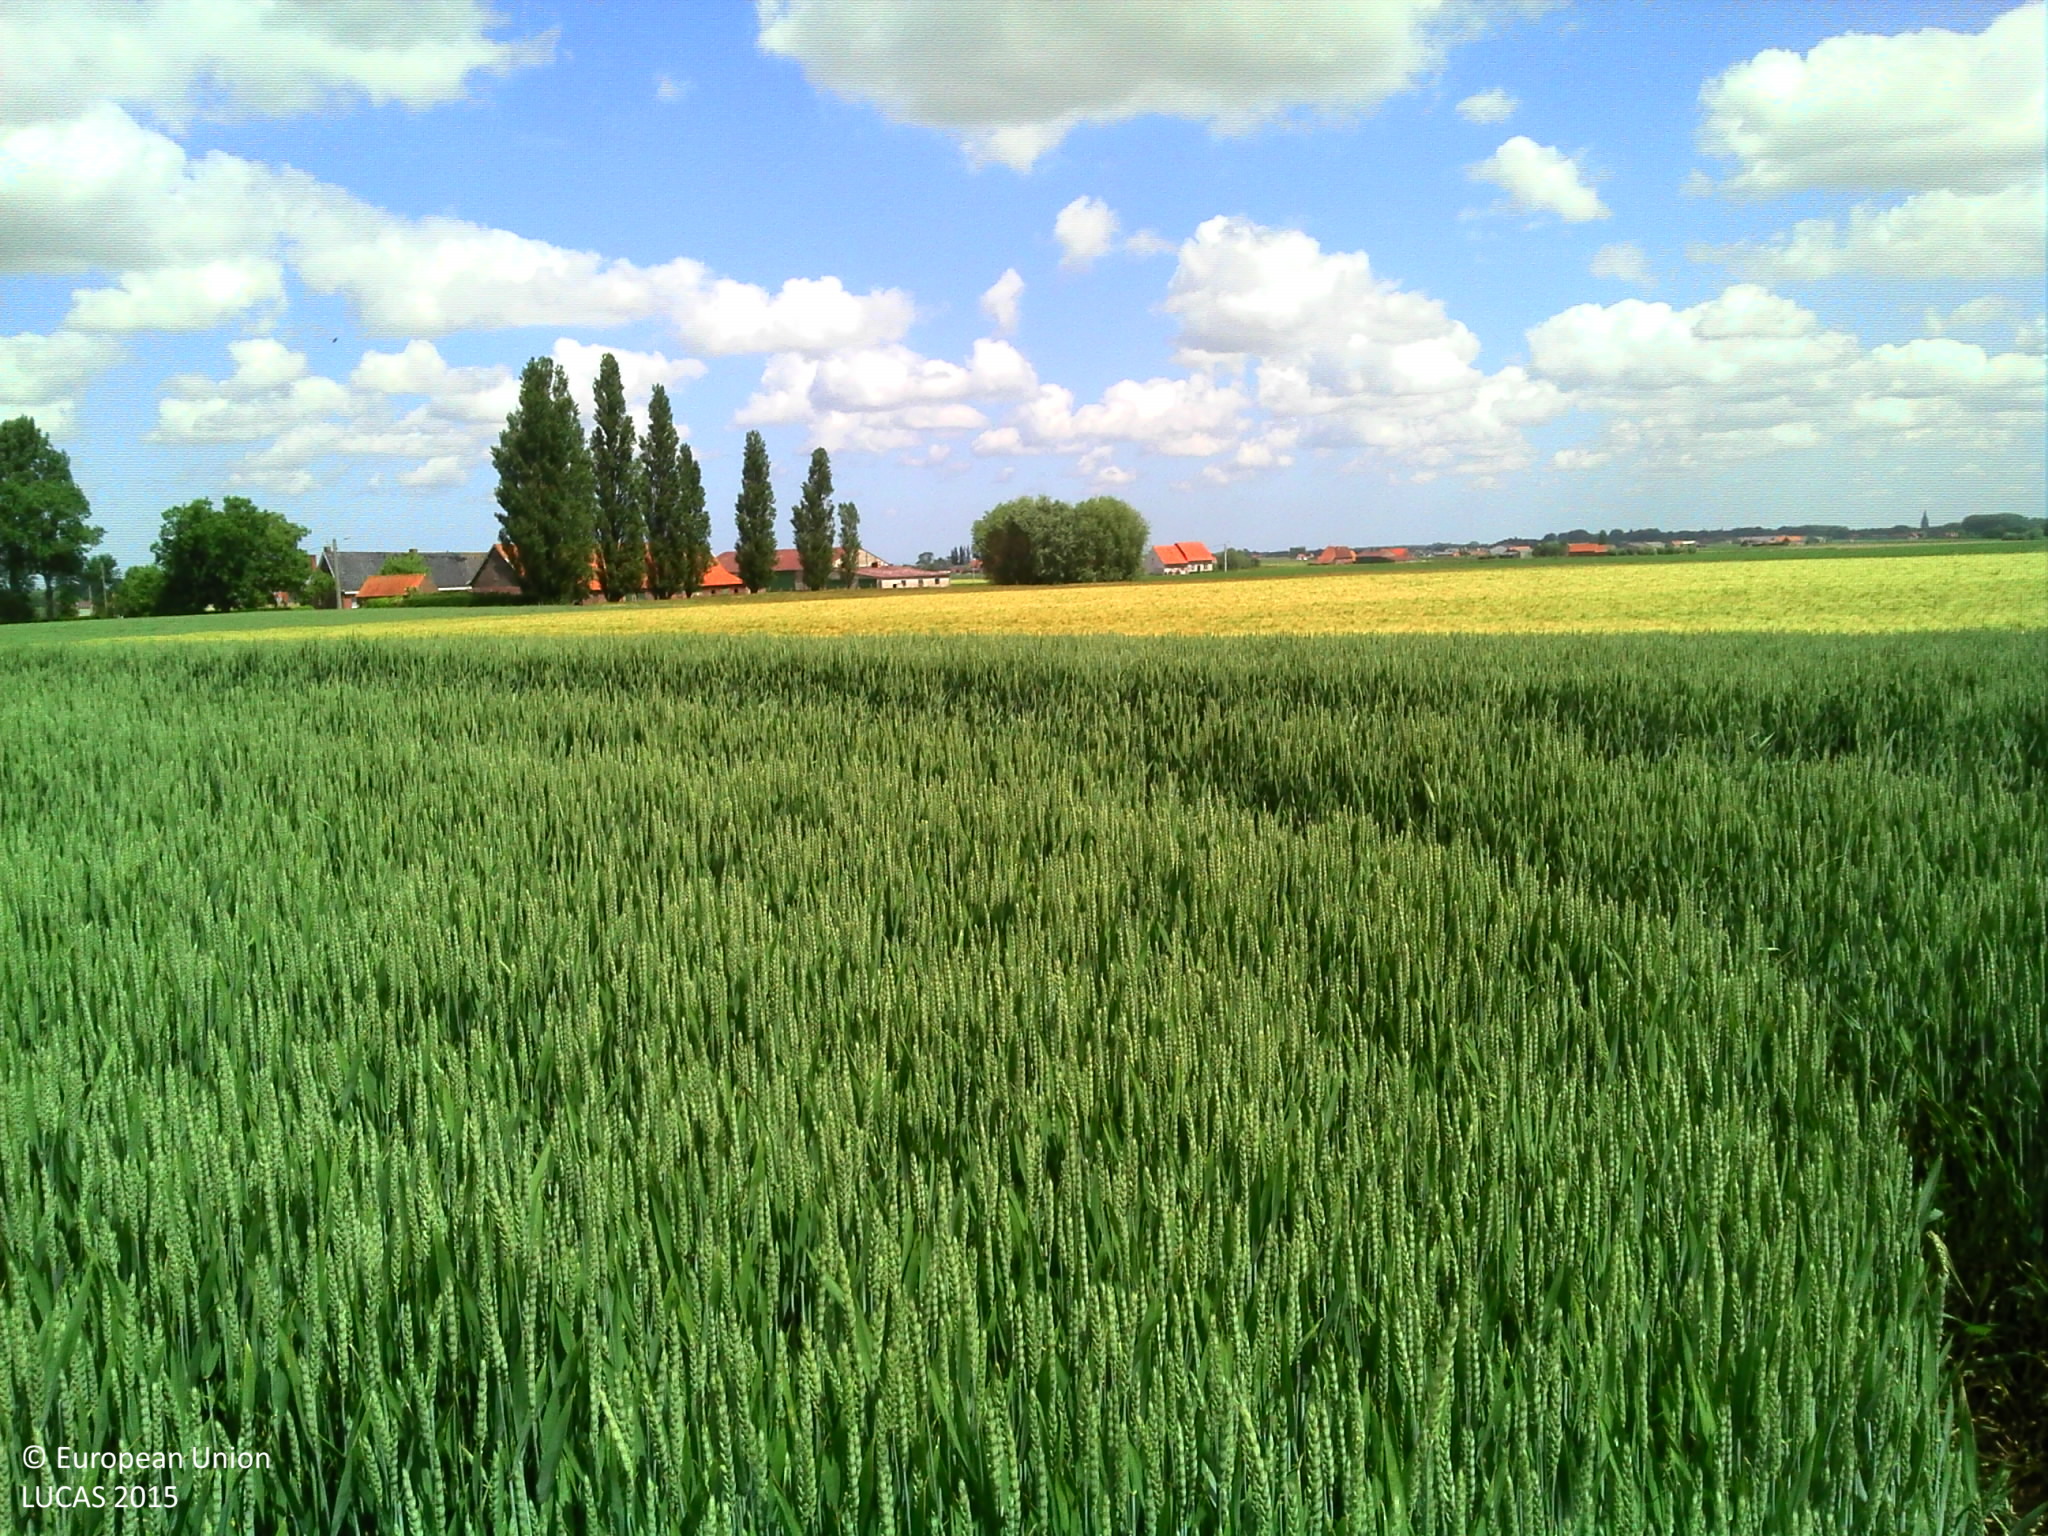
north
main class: Cropland
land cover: Common wheat
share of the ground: > 75 %
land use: Agriculture (excluding fallow land and kitchen gardens)
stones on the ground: < 10 %
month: June
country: BE
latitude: 50.8225
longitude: 2.7917
